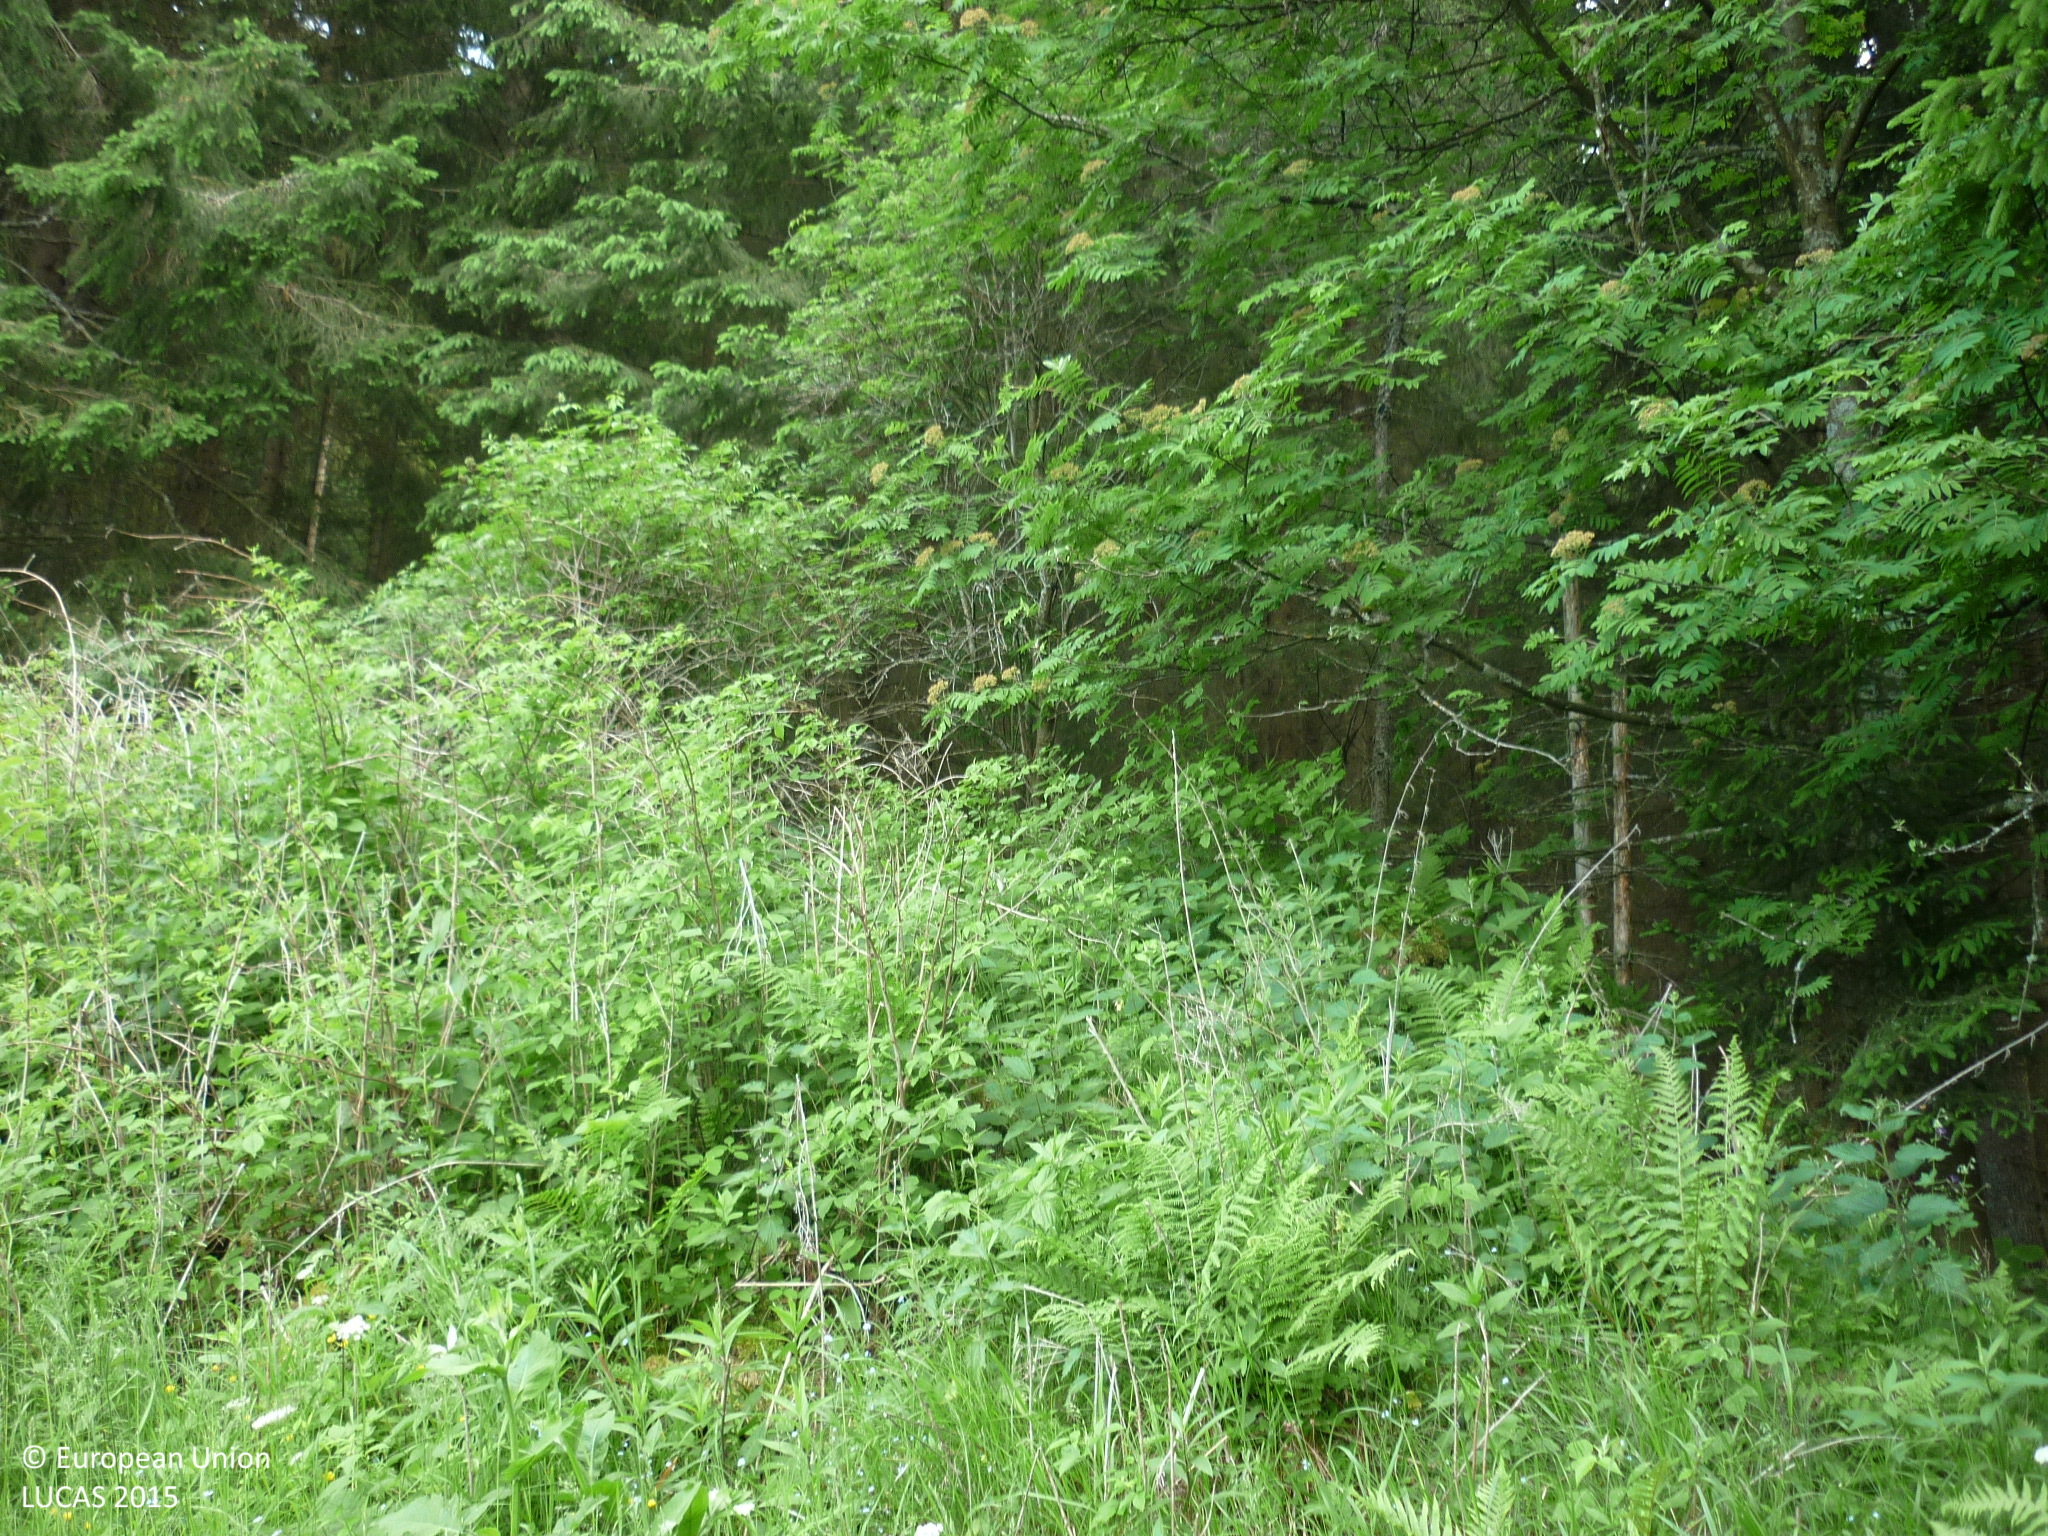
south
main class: Grassland
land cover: Grassland without tree/shrub cover
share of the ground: > 75 %
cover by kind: herbaceous plants 100 %
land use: Agriculture (excluding fallow land and kitchen gardens)
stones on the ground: < 10 %
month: June
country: AT
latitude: 47.2198
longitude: 14.3166
